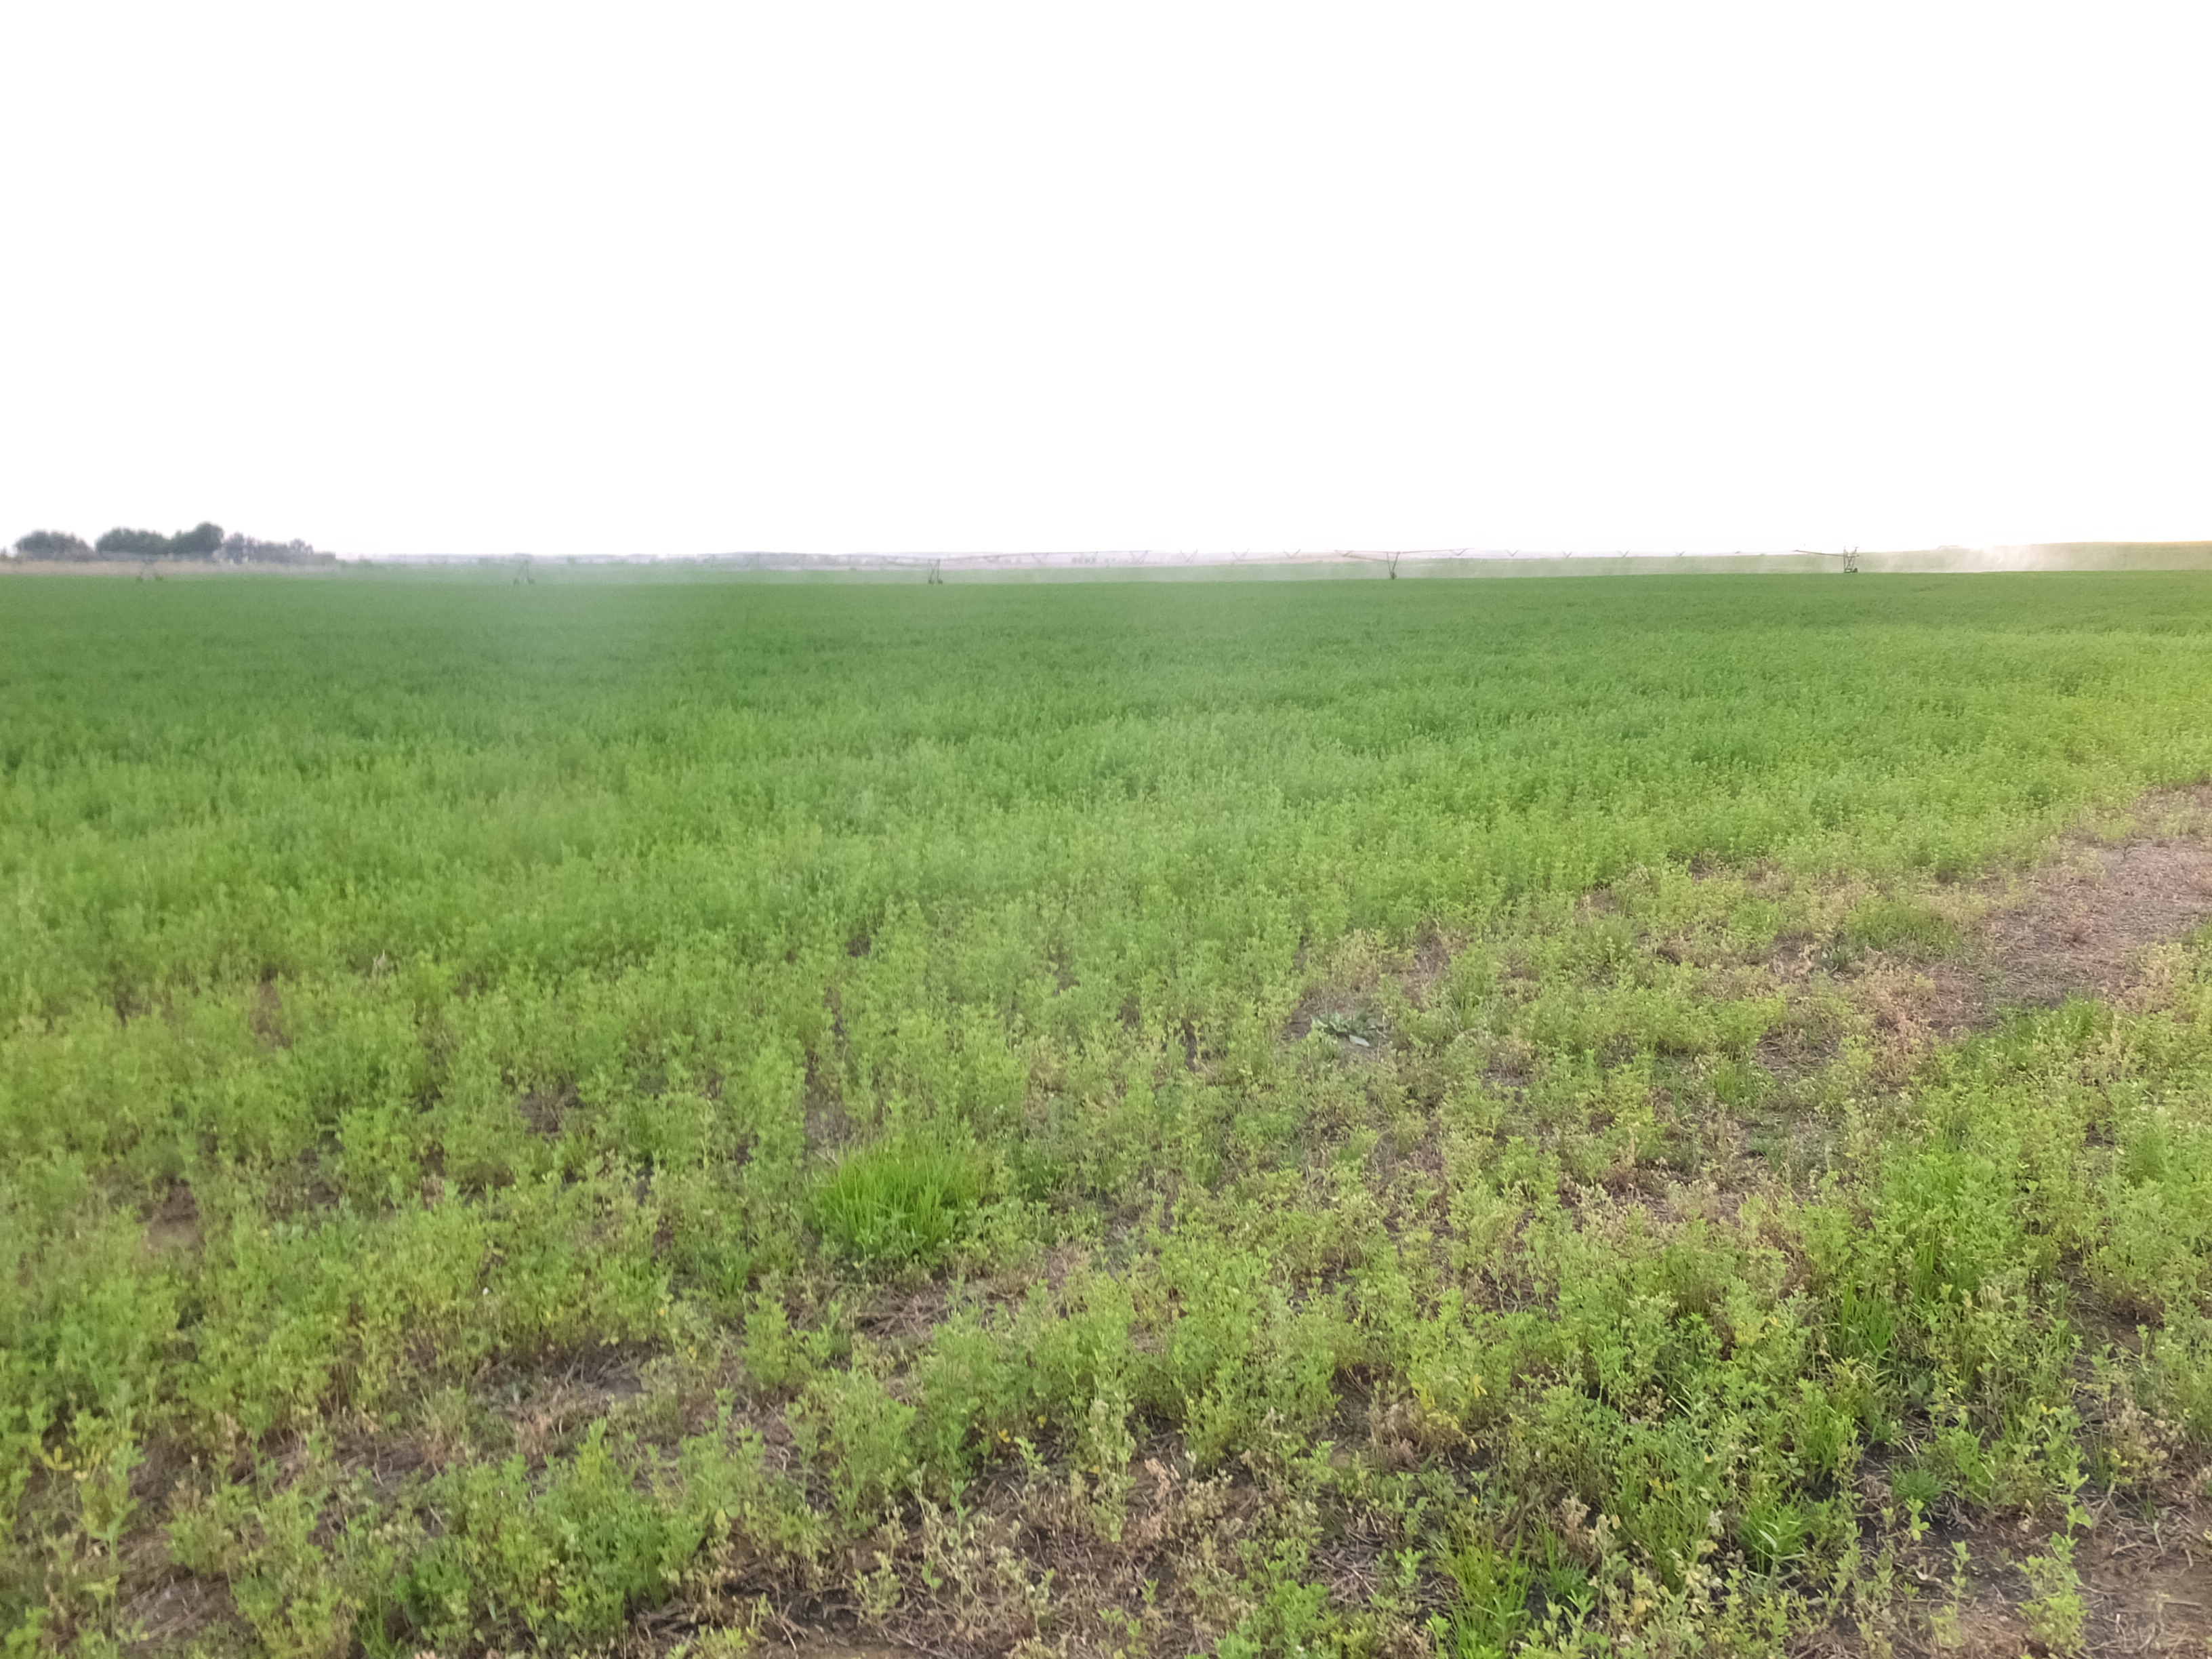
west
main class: Cropland
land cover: Lucerne
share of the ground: > 75 %
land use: Agriculture (excluding fallow land and kitchen gardens)
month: July
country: ES
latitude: 41.7717
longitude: 0.3250
